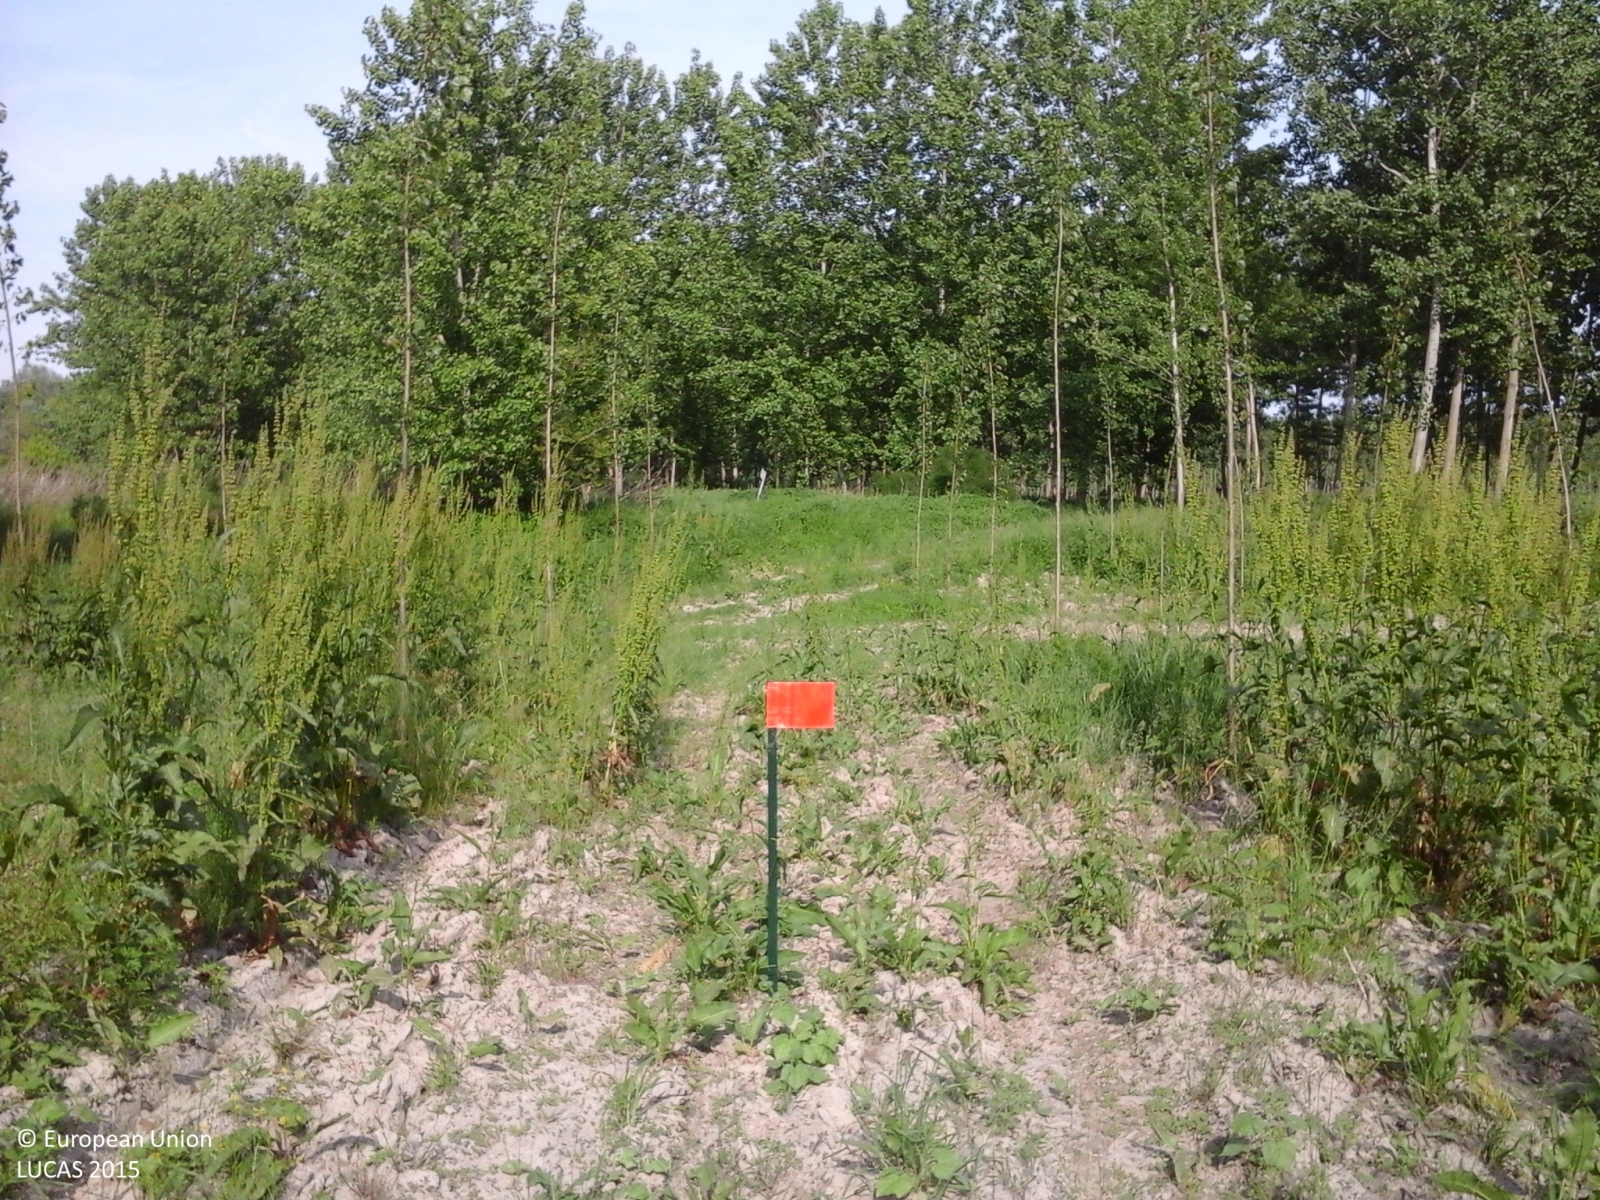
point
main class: Woodland
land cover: Broadleaved woodland
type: exotic forest
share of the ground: 25 - 50 %
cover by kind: herbaceous plants 85 %, broadleaved forest trees 10 %, unconsolidated bare surface 5 %
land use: Forestry
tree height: > 5 m
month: May
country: IT
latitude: 44.9812
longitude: 10.3164
